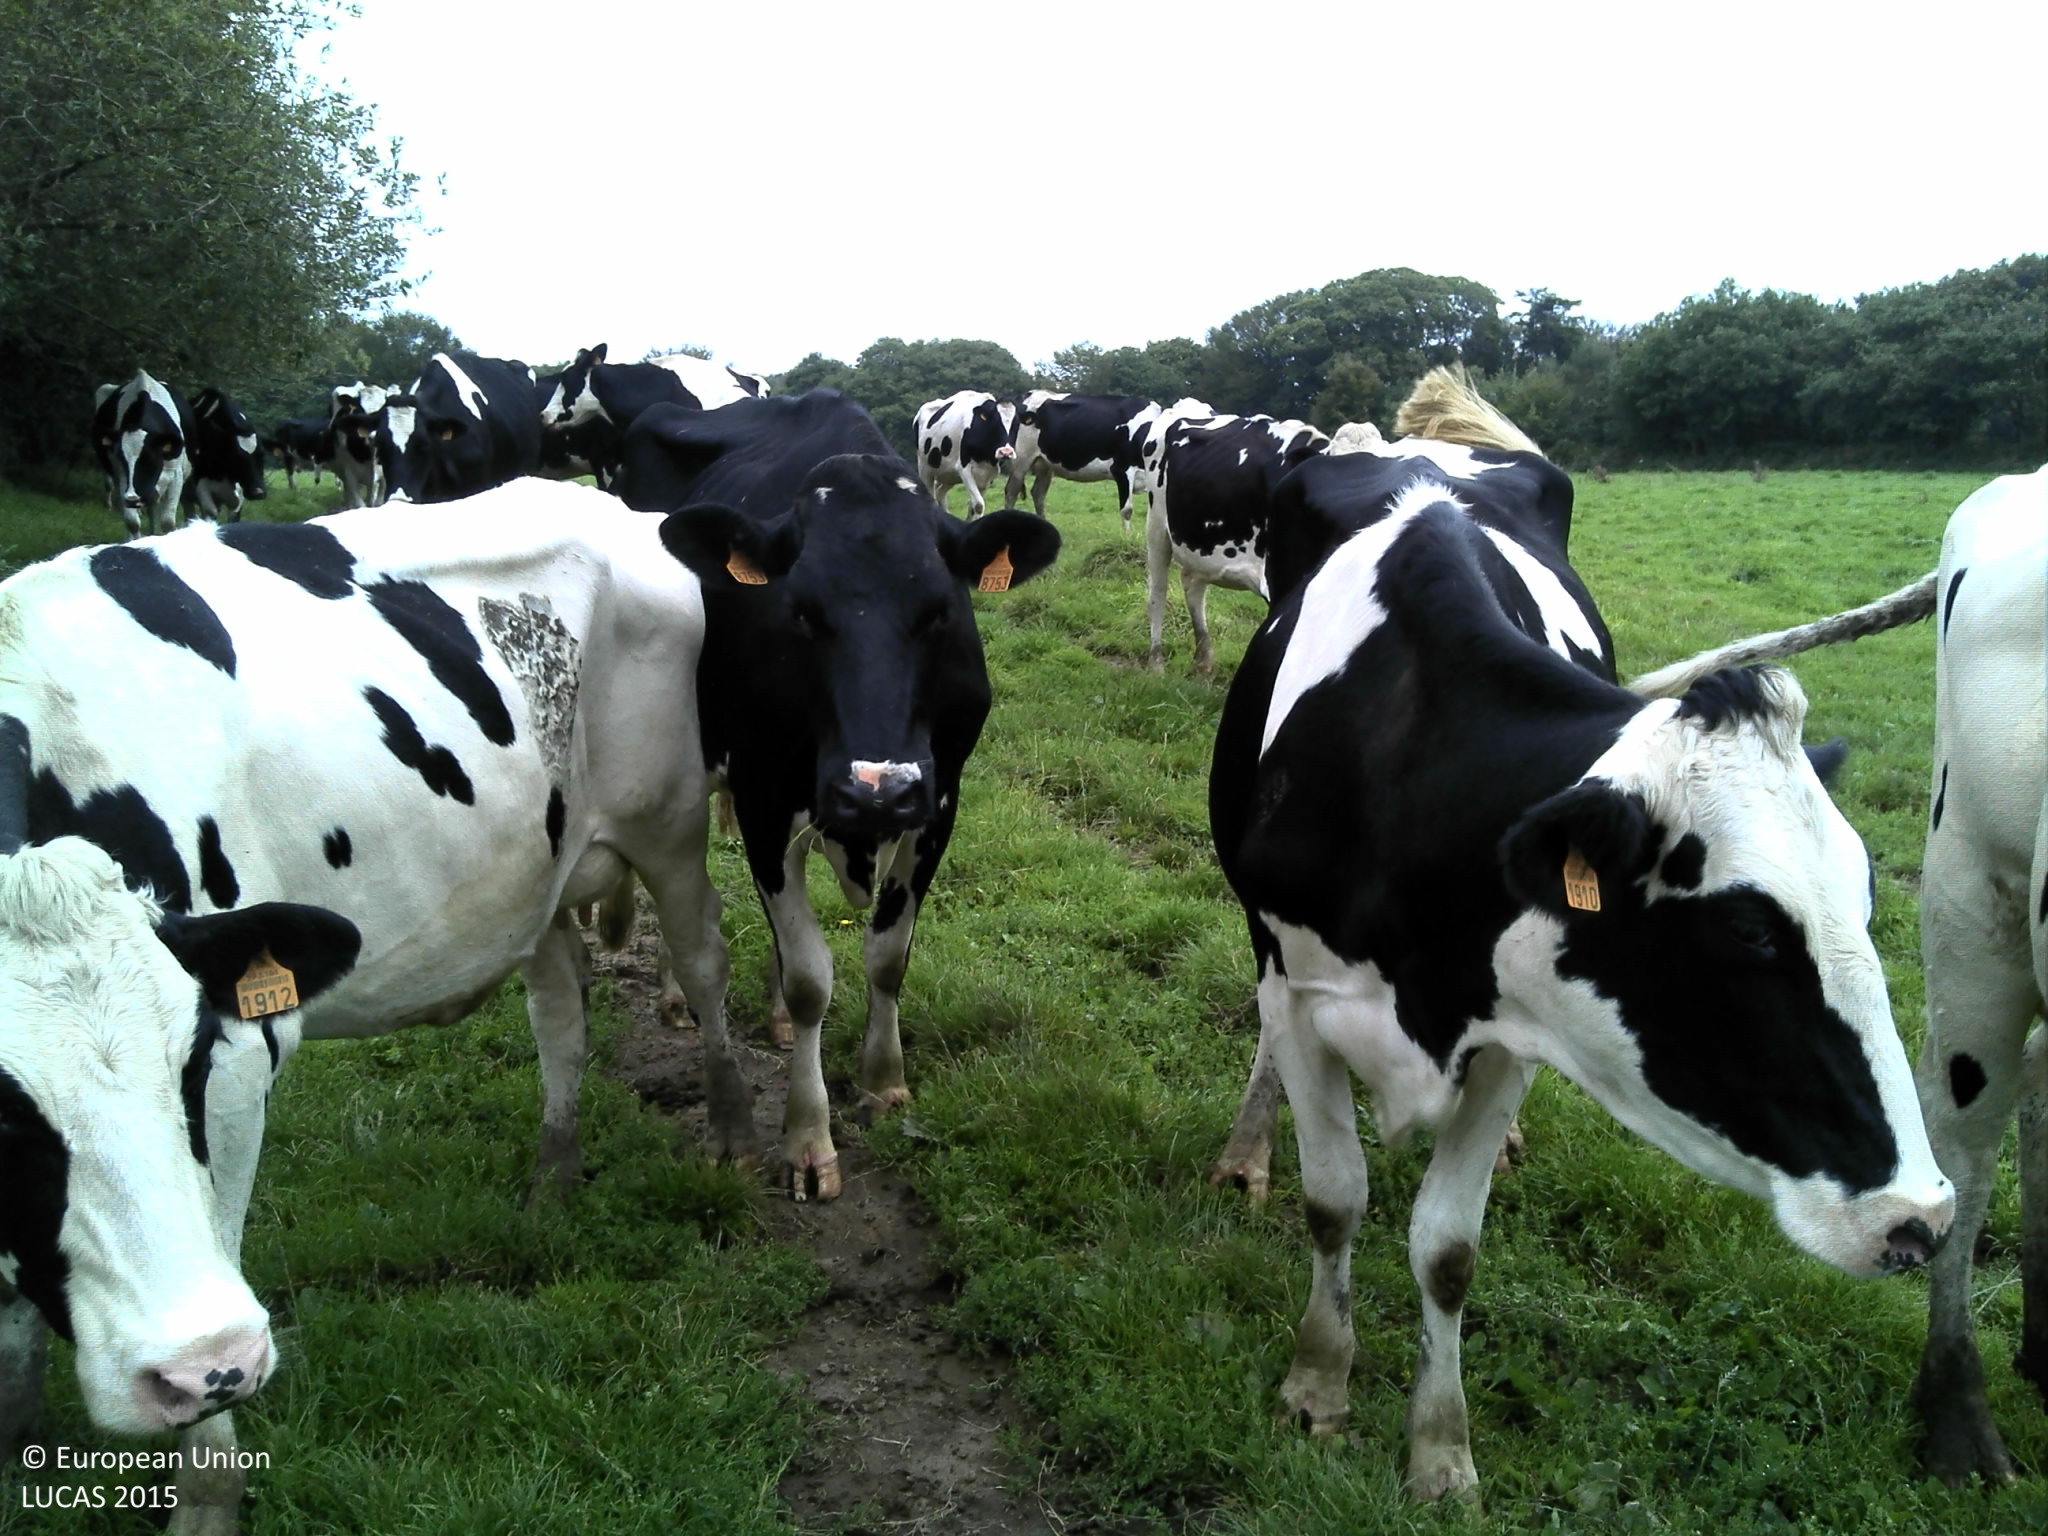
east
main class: Grassland
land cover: Grassland without tree/shrub cover
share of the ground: > 75 %
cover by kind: herbaceous plants 100 %
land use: Agriculture (excluding fallow land and kitchen gardens)
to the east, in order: Grassland without tree/shrub cover; Fences; Grassland without tree/shrub cover; Fences; Broadleaved woodland; Tracks; Broadleaved woodland; Grassland without tree/shrub cover; Rivers and streams; Grassland without tree/shrub cover; Broadleaved woodland
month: August
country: FR
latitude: 48.5488
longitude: -4.2780
